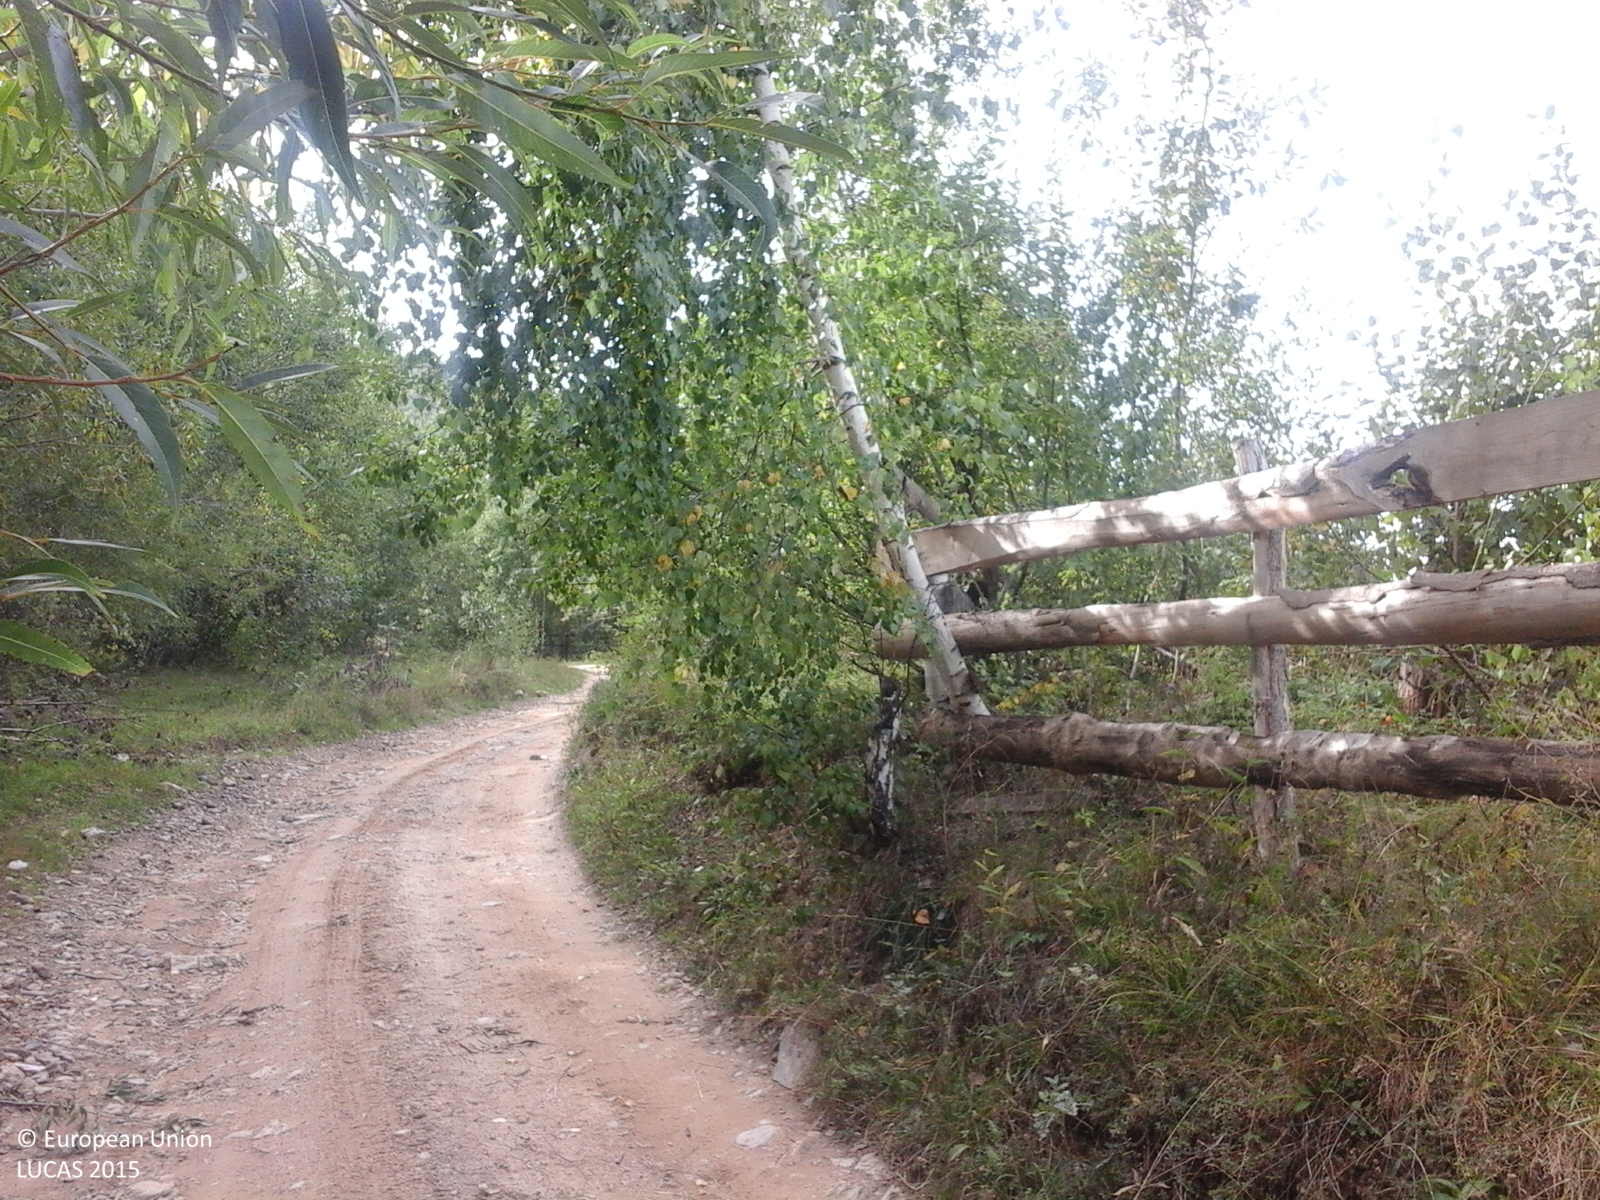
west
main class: Grassland
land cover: Grassland without tree/shrub cover
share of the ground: > 75 %
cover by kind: herbaceous plants 100 %
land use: Agriculture (excluding fallow land and kitchen gardens)
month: September
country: RO
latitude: 46.6649
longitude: 23.3050
